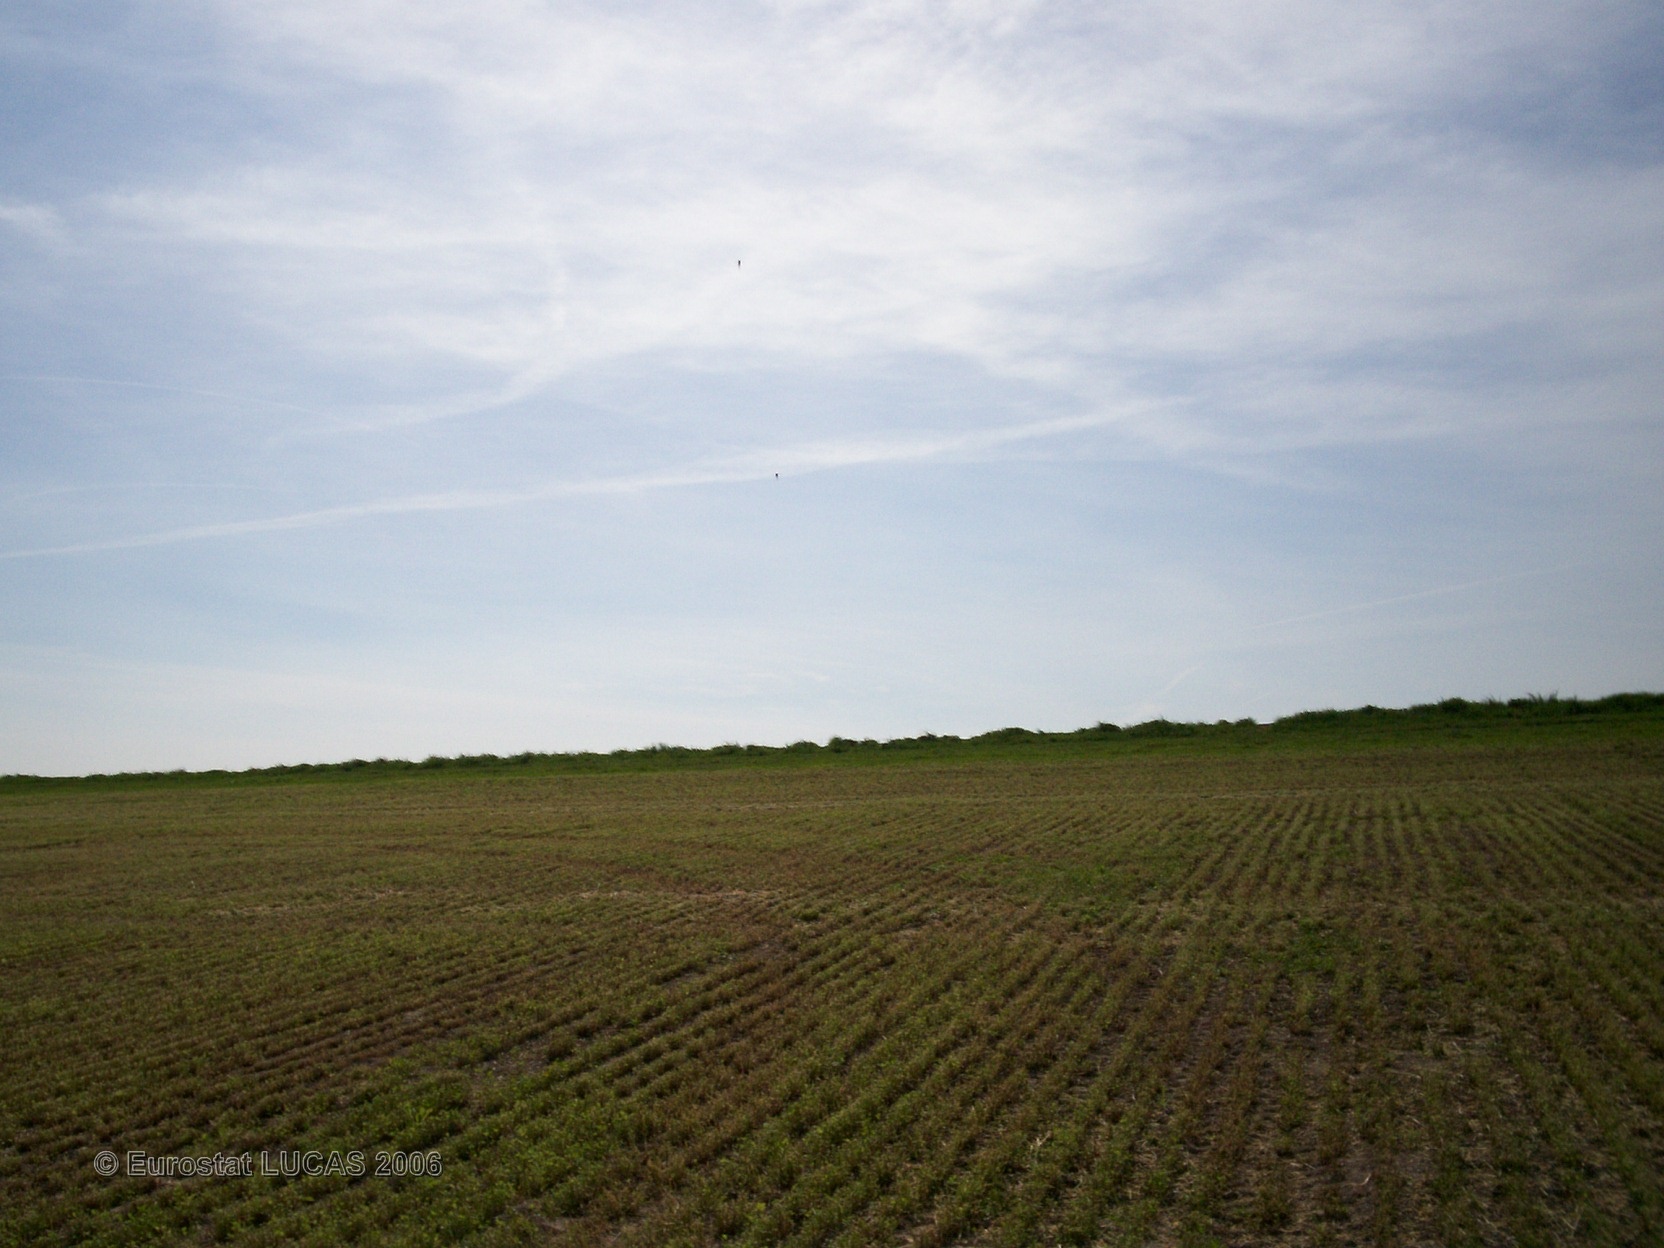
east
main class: Cropland
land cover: Lucerne
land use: Agriculture (excluding fallow land and kitchen gardens)
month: May
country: FR
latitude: 48.8399
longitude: 4.4239
